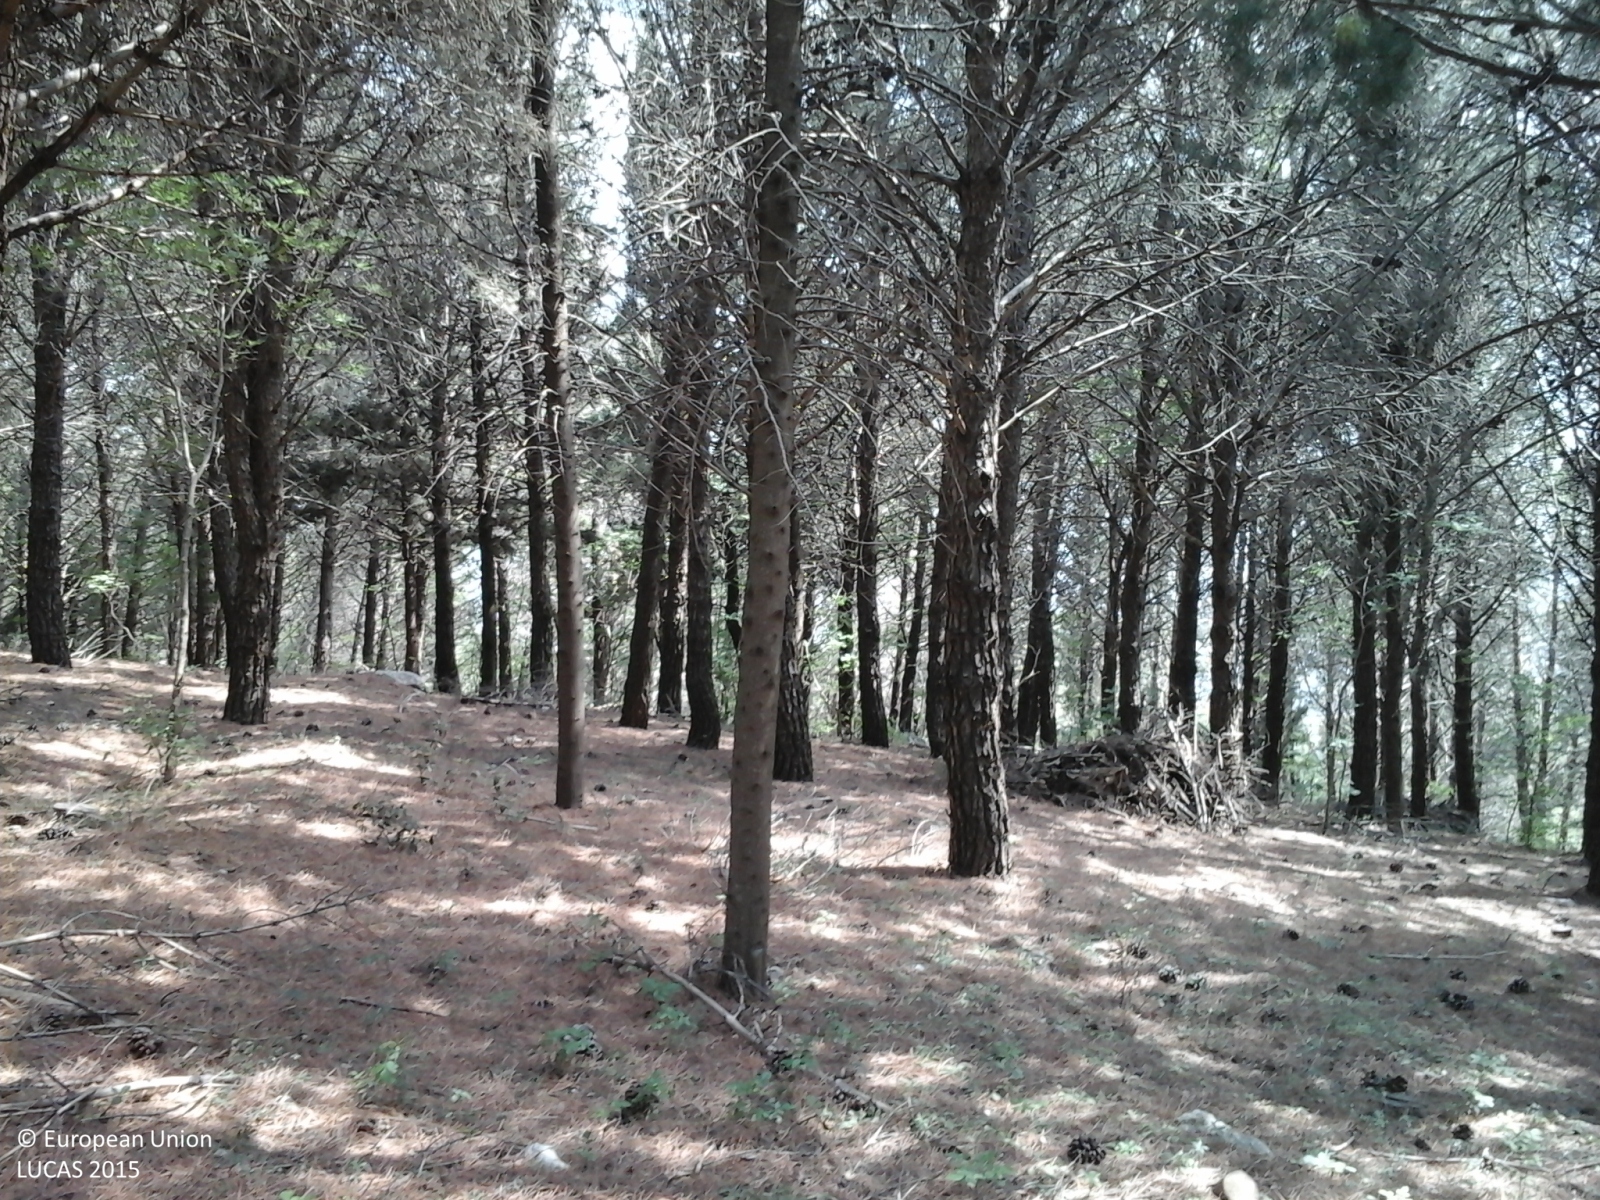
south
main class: Woodland
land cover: Pine dominated coniferous woodland
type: coniferous forest of the mediterranean region
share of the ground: > 75 %
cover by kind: coniferous forest trees 90 %, consolidated bare surface 10 %
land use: Forestry
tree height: > 5 m
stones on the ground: < 10 %
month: July
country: IT
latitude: 37.6106
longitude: 13.4969
